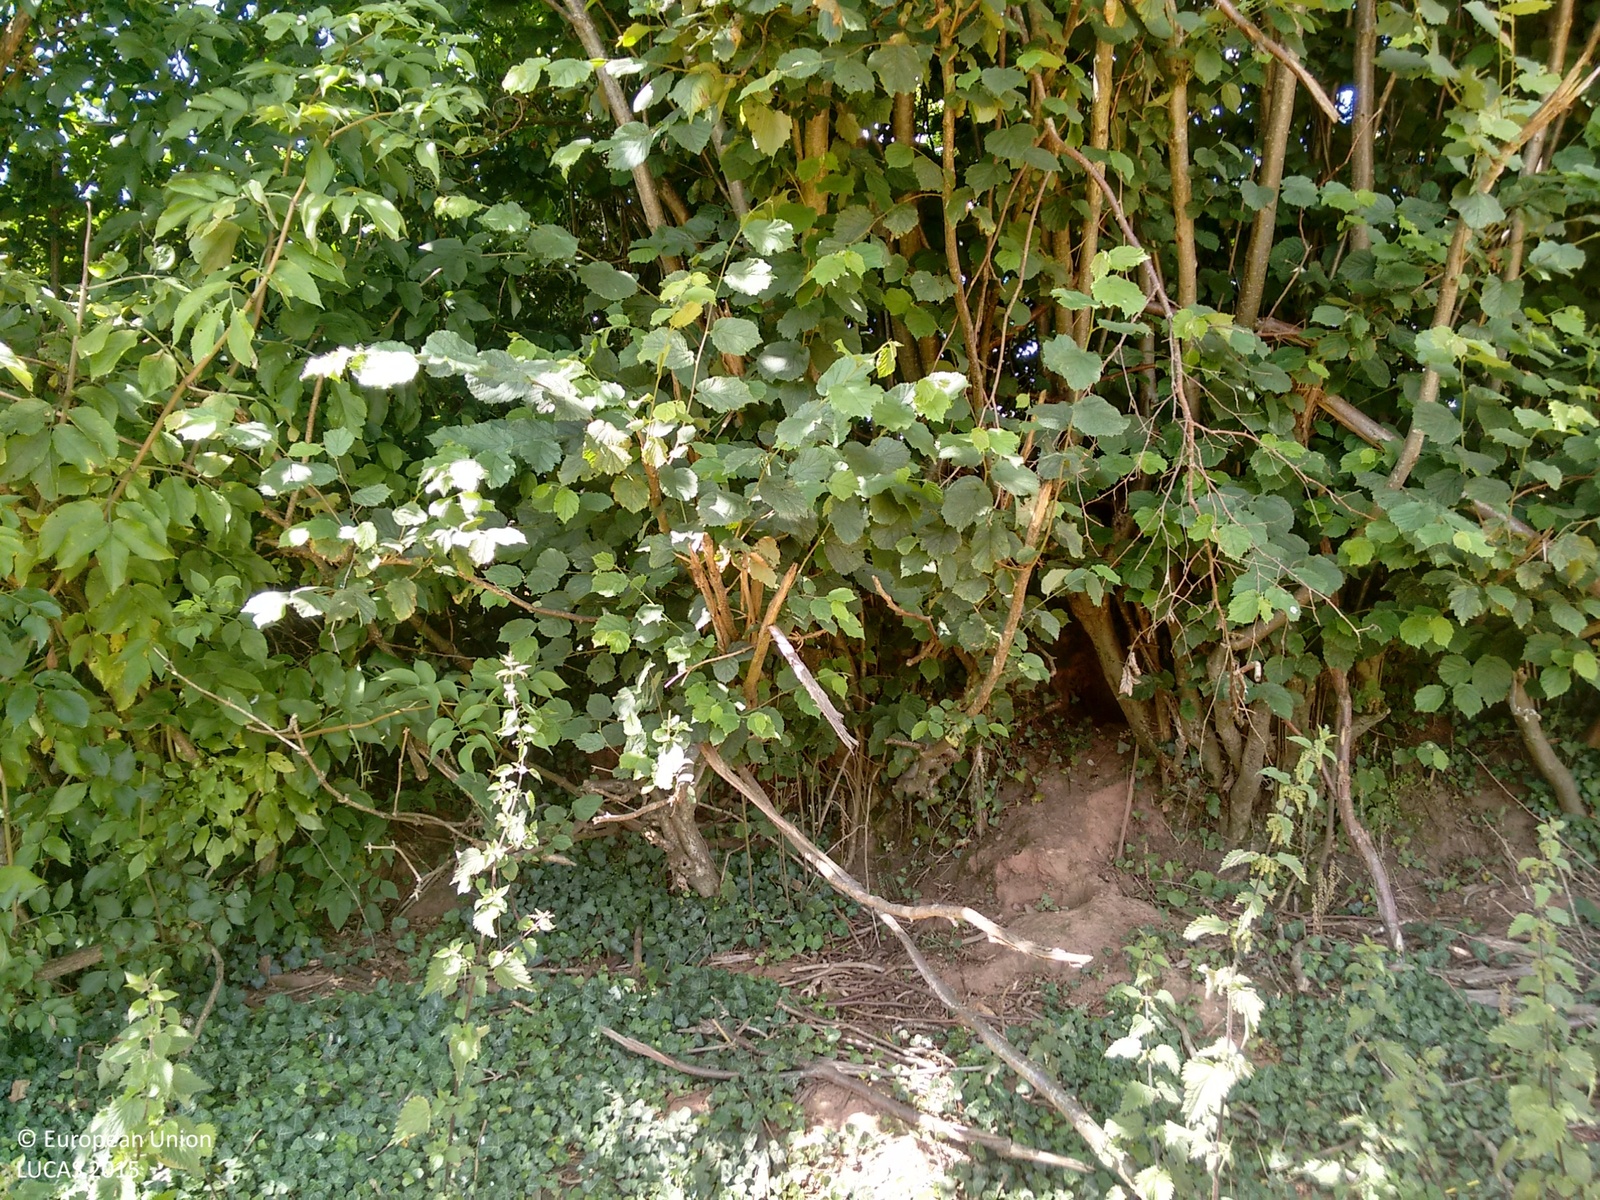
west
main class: Cropland
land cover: Barley
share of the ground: > 75 %
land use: Agriculture (excluding fallow land and kitchen gardens)
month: July
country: GB
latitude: 50.8001
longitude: -3.4921
